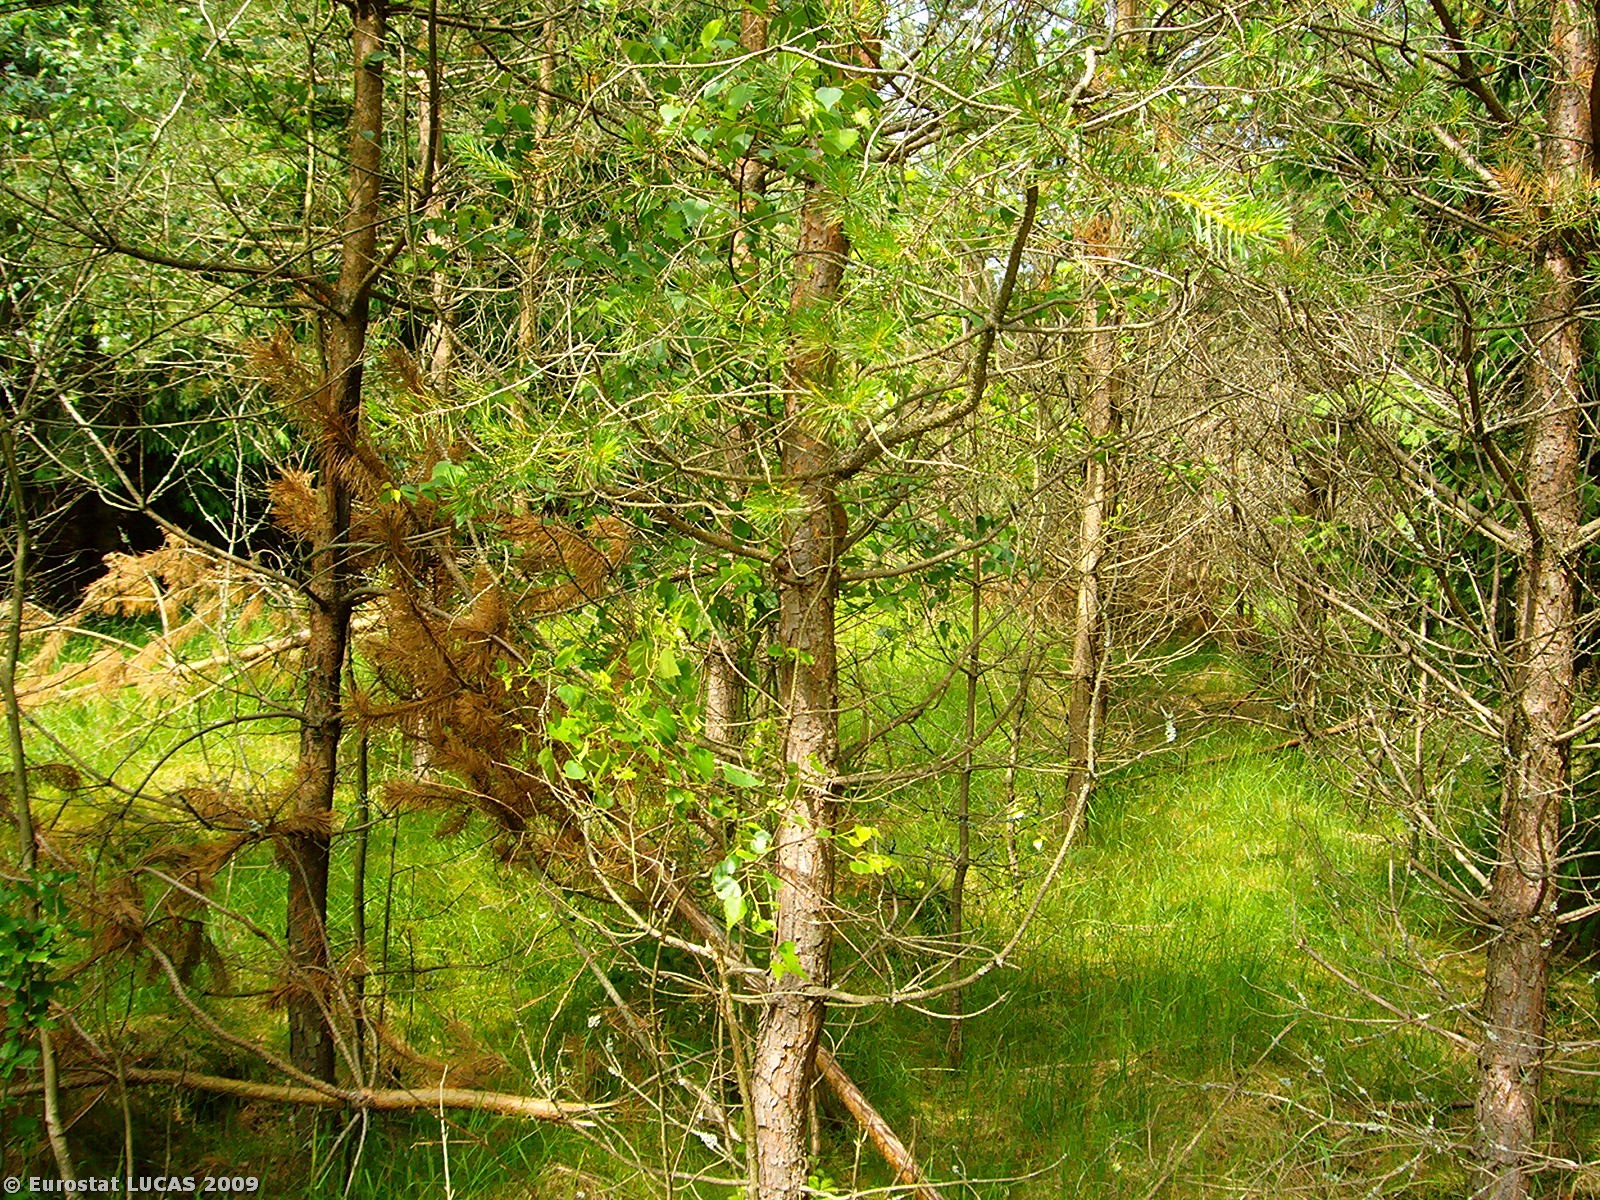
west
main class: Woodland
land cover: Mixed woodland
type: hemiboreal forest and nemoral coniferous forest and mixed broadleaved-coniferous forest
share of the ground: 50 - 75 %
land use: Forestry
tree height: > 5 m
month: June
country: PL
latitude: 53.8719
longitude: 15.4934
